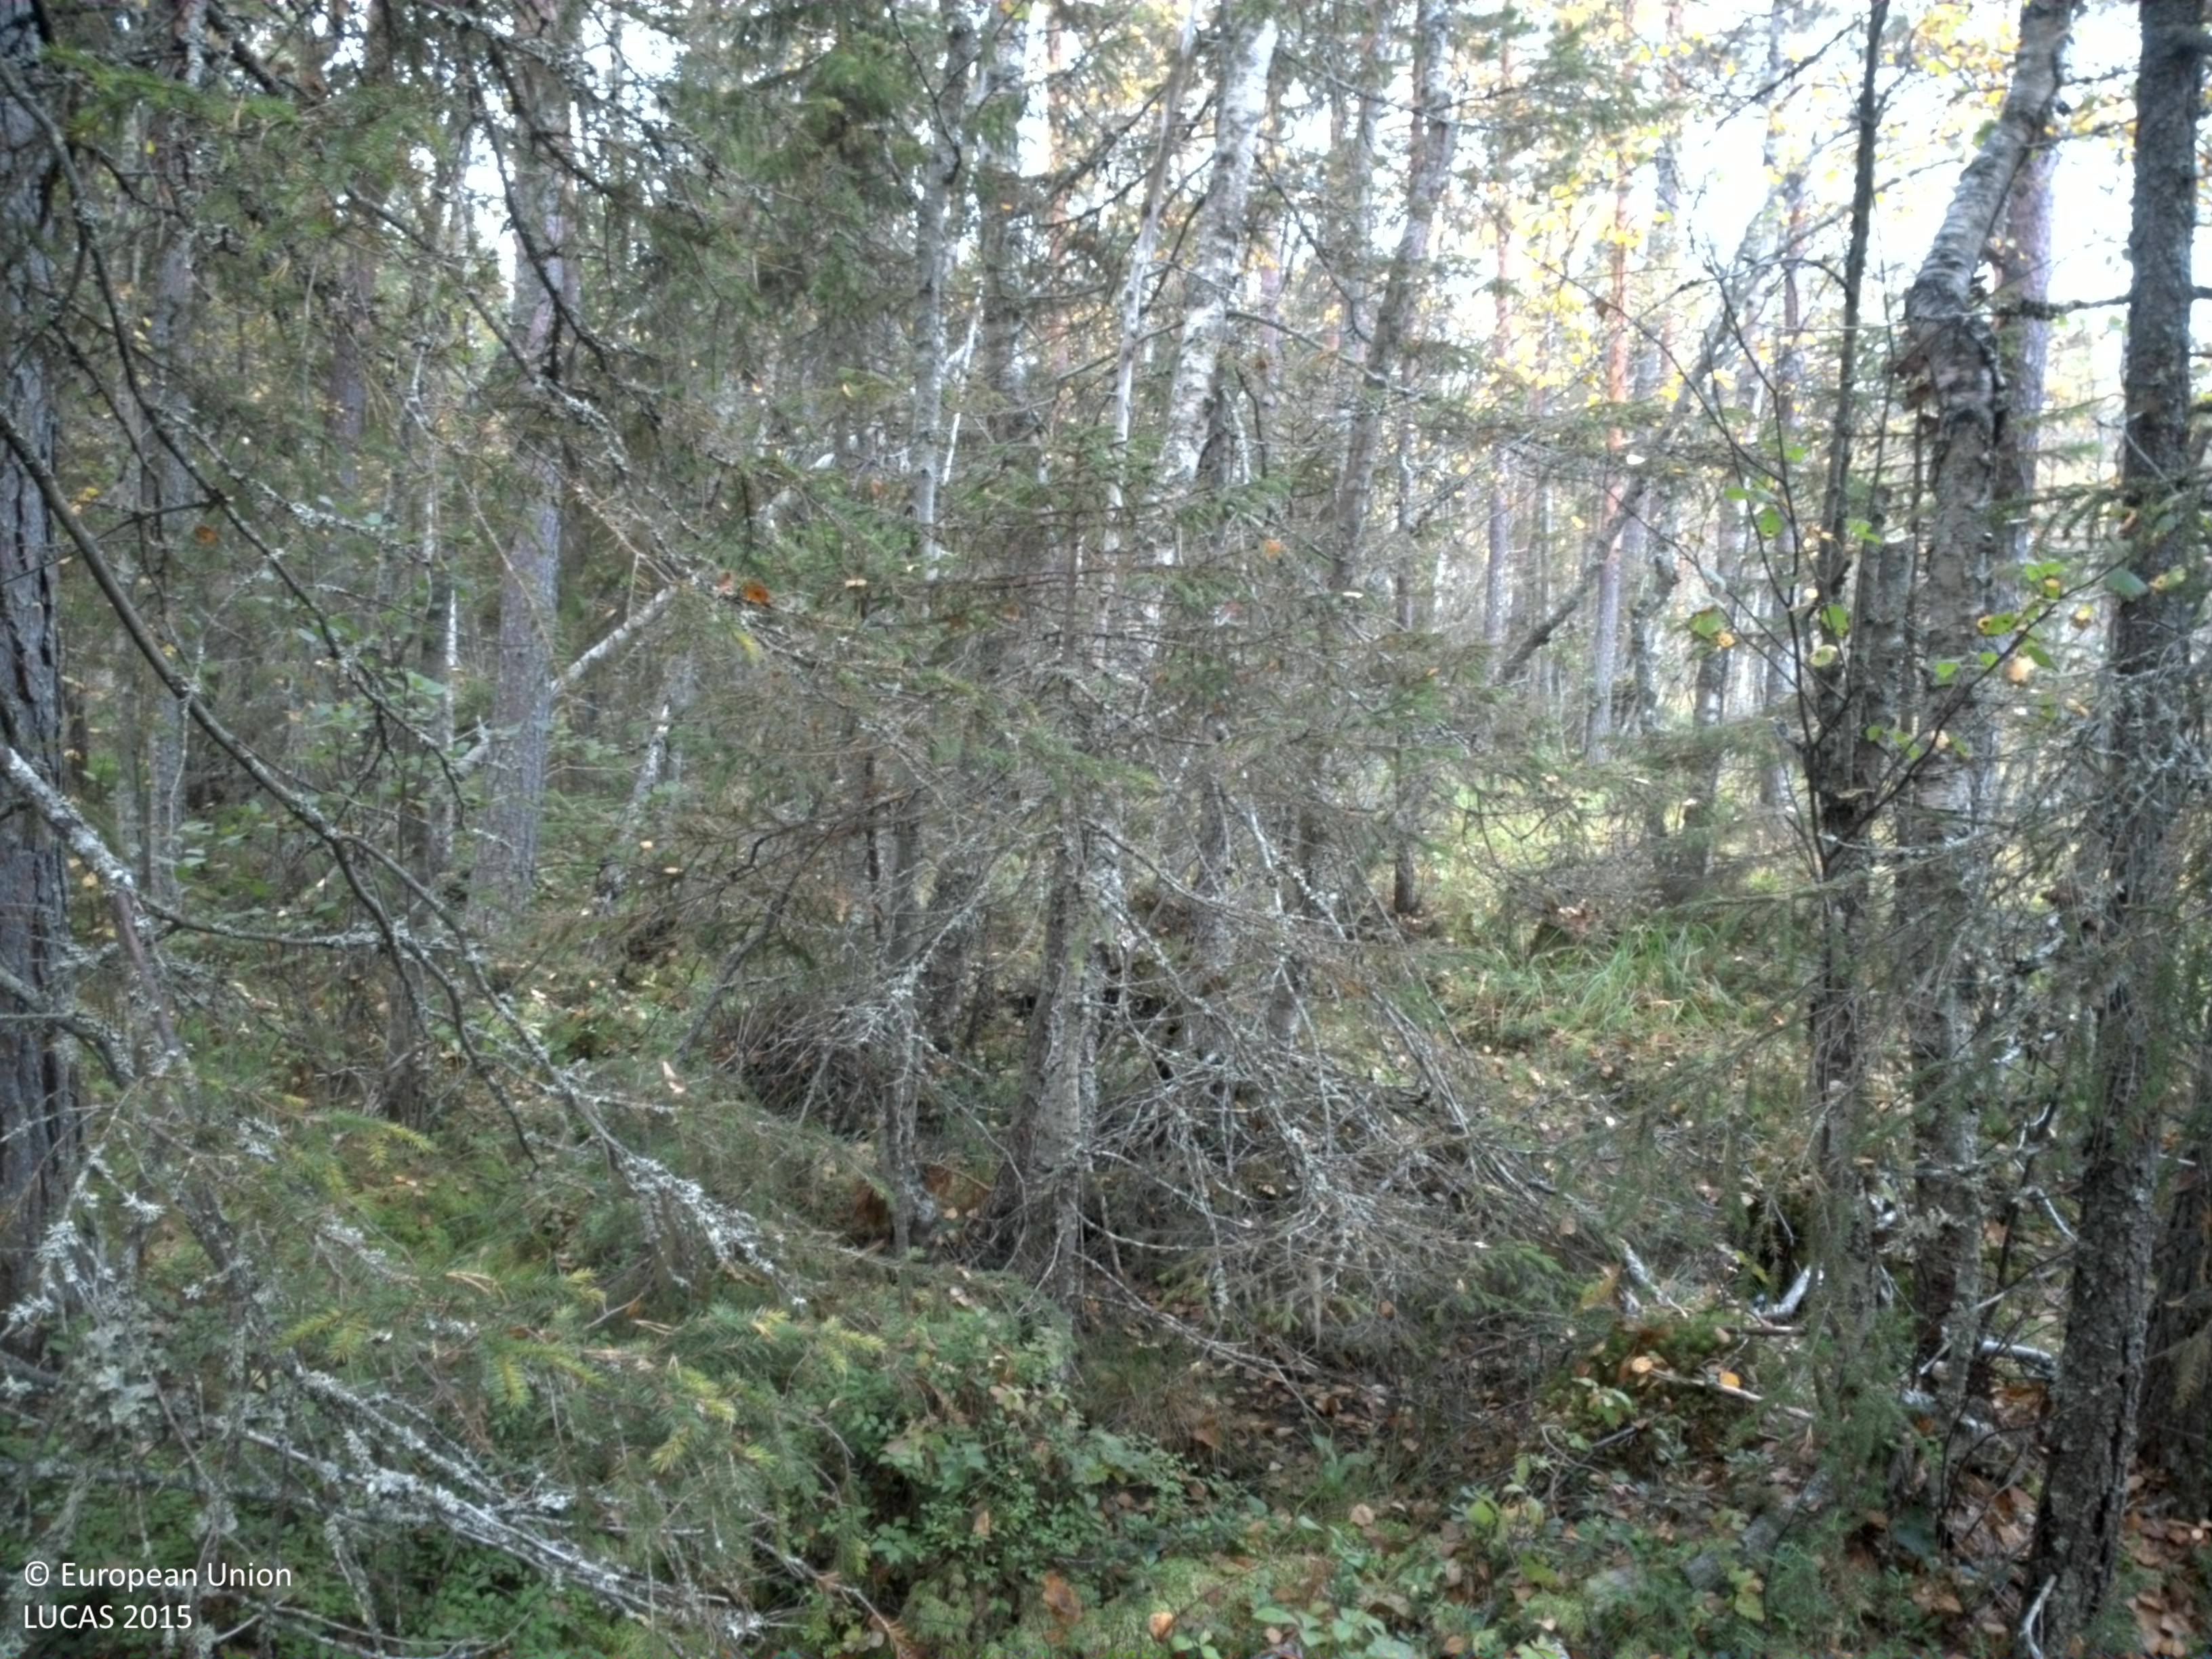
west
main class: Woodland
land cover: Pine dominated mixed woodland
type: boreal forest
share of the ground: 25 - 50 %
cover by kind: shrubs 45 %, coniferous forest trees 30 %, broadleaved forest trees 15 %, lichens and mosses 10 %
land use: Forestry
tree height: > 5 m
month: September
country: SE
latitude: 65.5328
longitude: 22.0316
